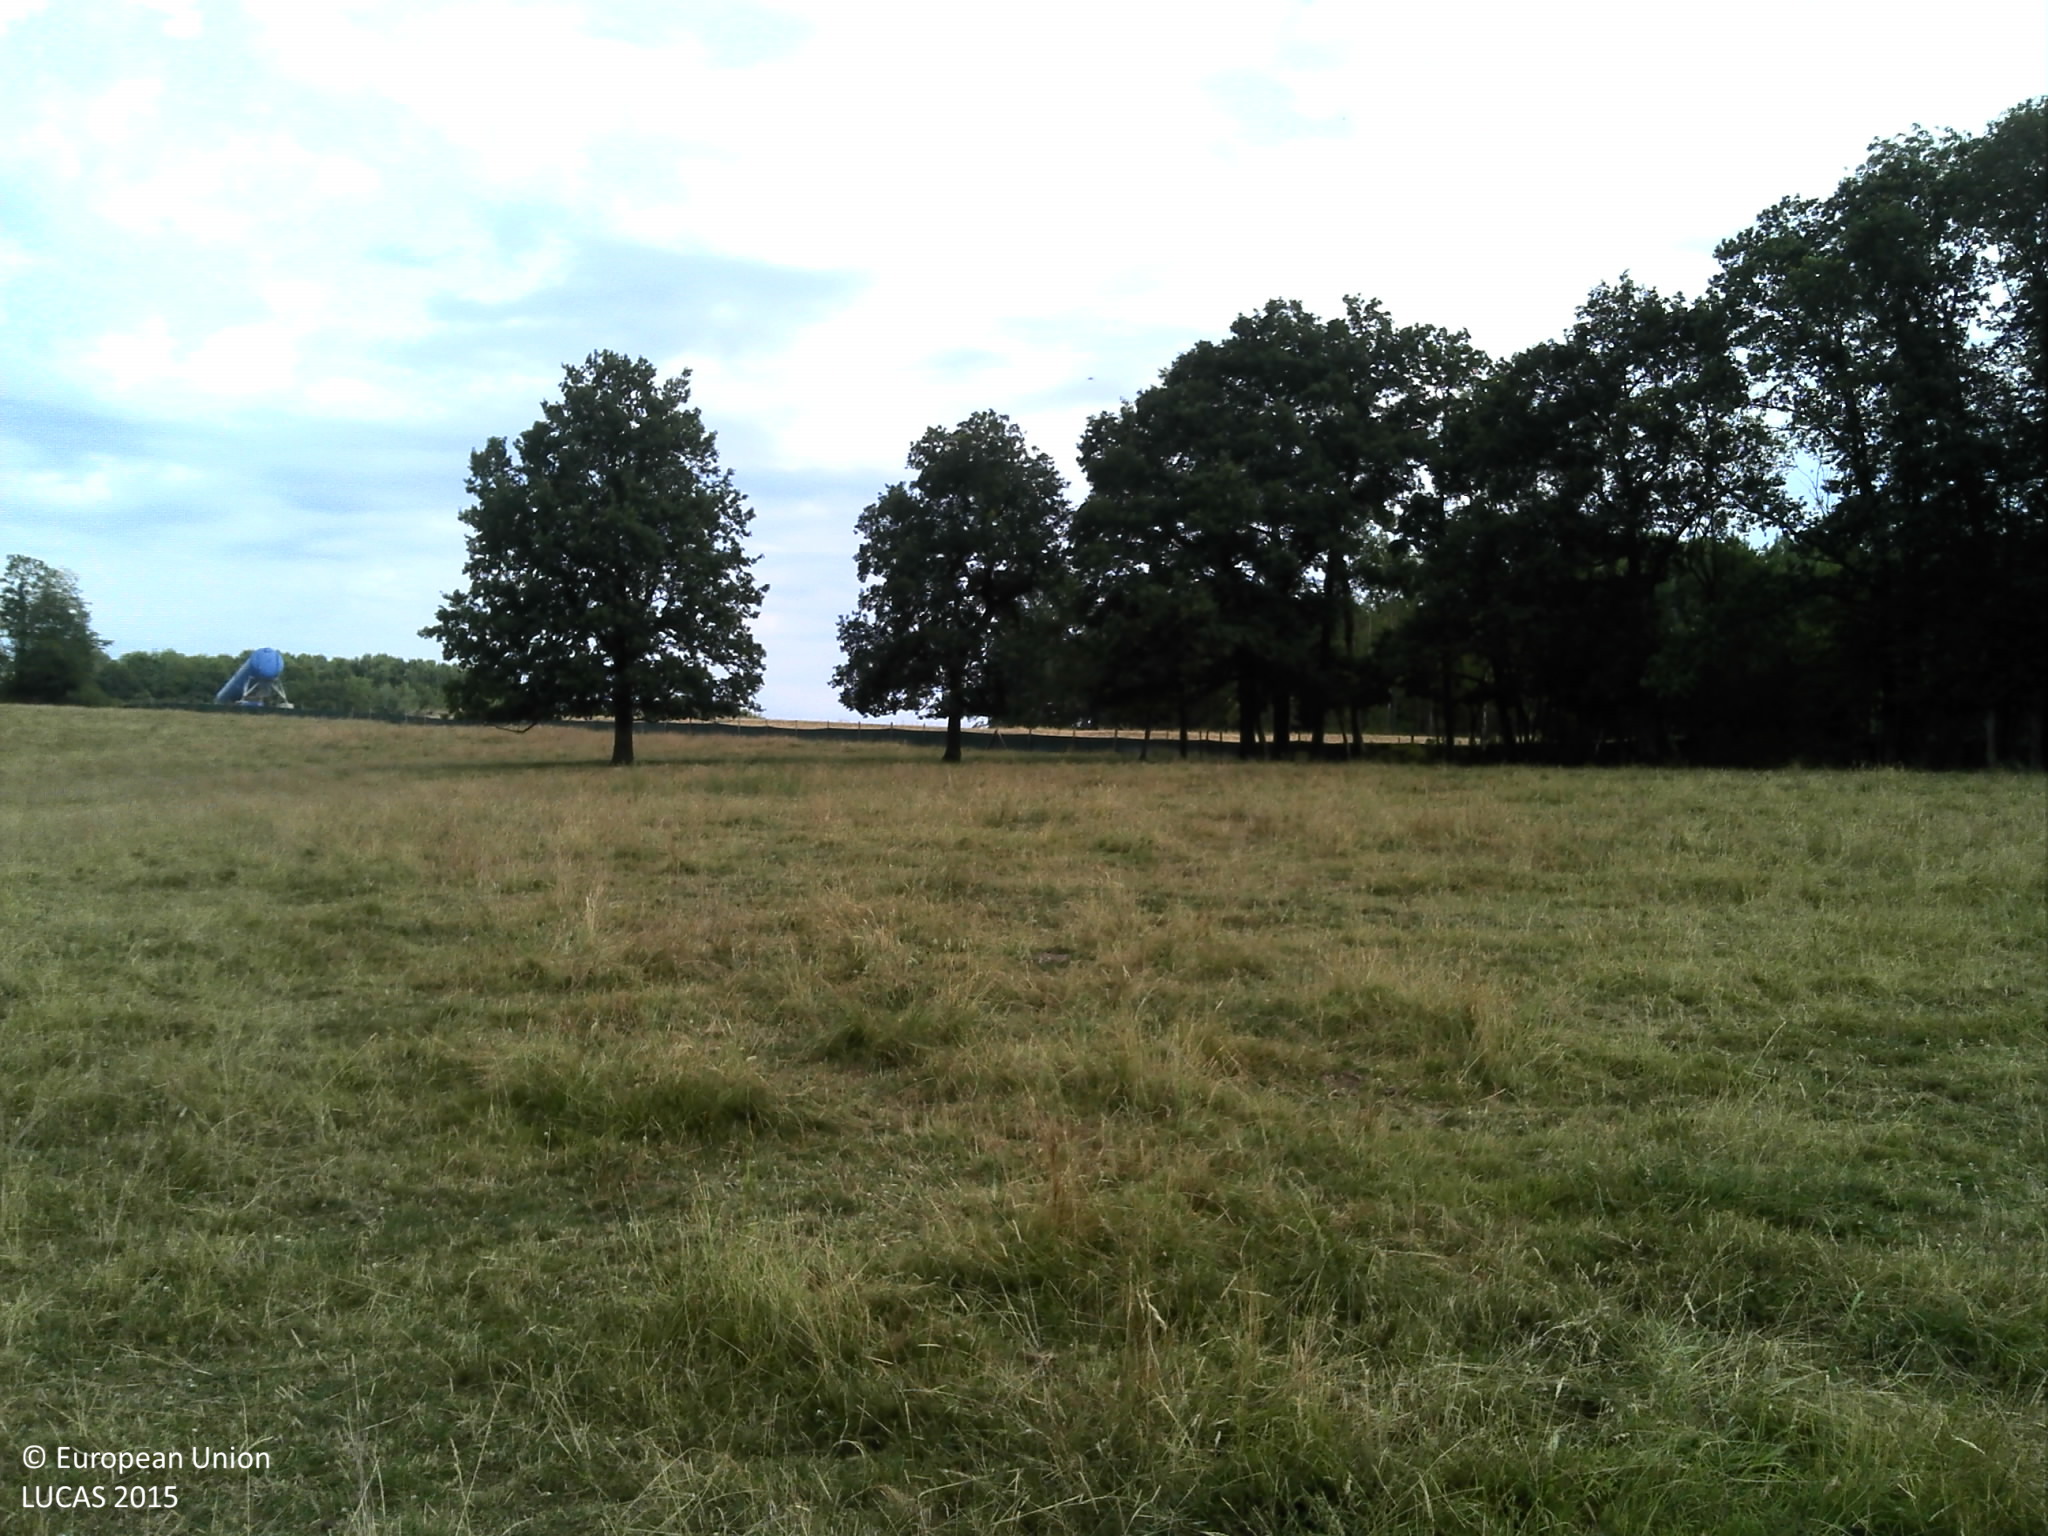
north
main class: Grassland
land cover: Grassland without tree/shrub cover
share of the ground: > 75 %
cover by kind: herbaceous plants 100 %
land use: Agriculture (excluding fallow land and kitchen gardens)
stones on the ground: < 10 %
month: July
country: FR
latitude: 49.7358
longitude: 4.6825
